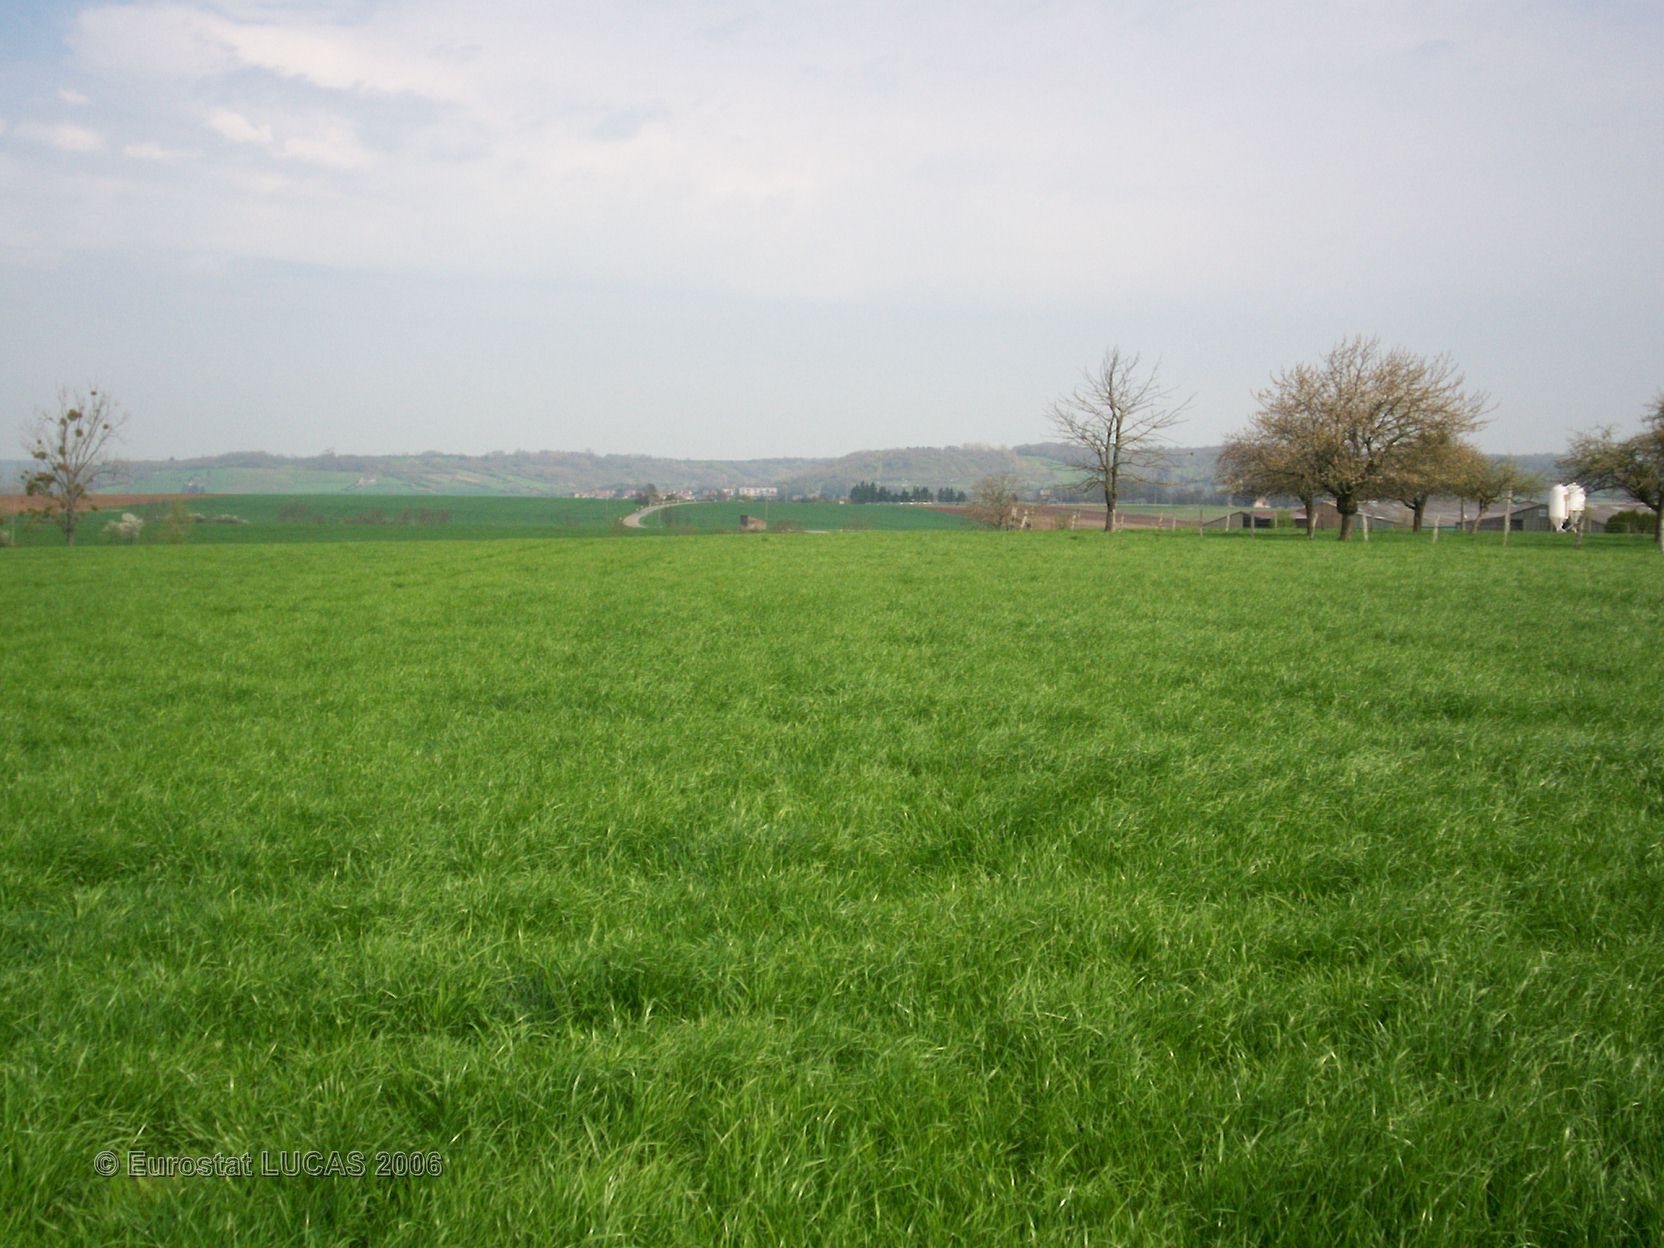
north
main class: Grassland
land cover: Grassland without tree/shrub cover
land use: Agriculture (excluding fallow land and kitchen gardens)
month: April
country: FR
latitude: 48.7633
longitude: 6.5312
